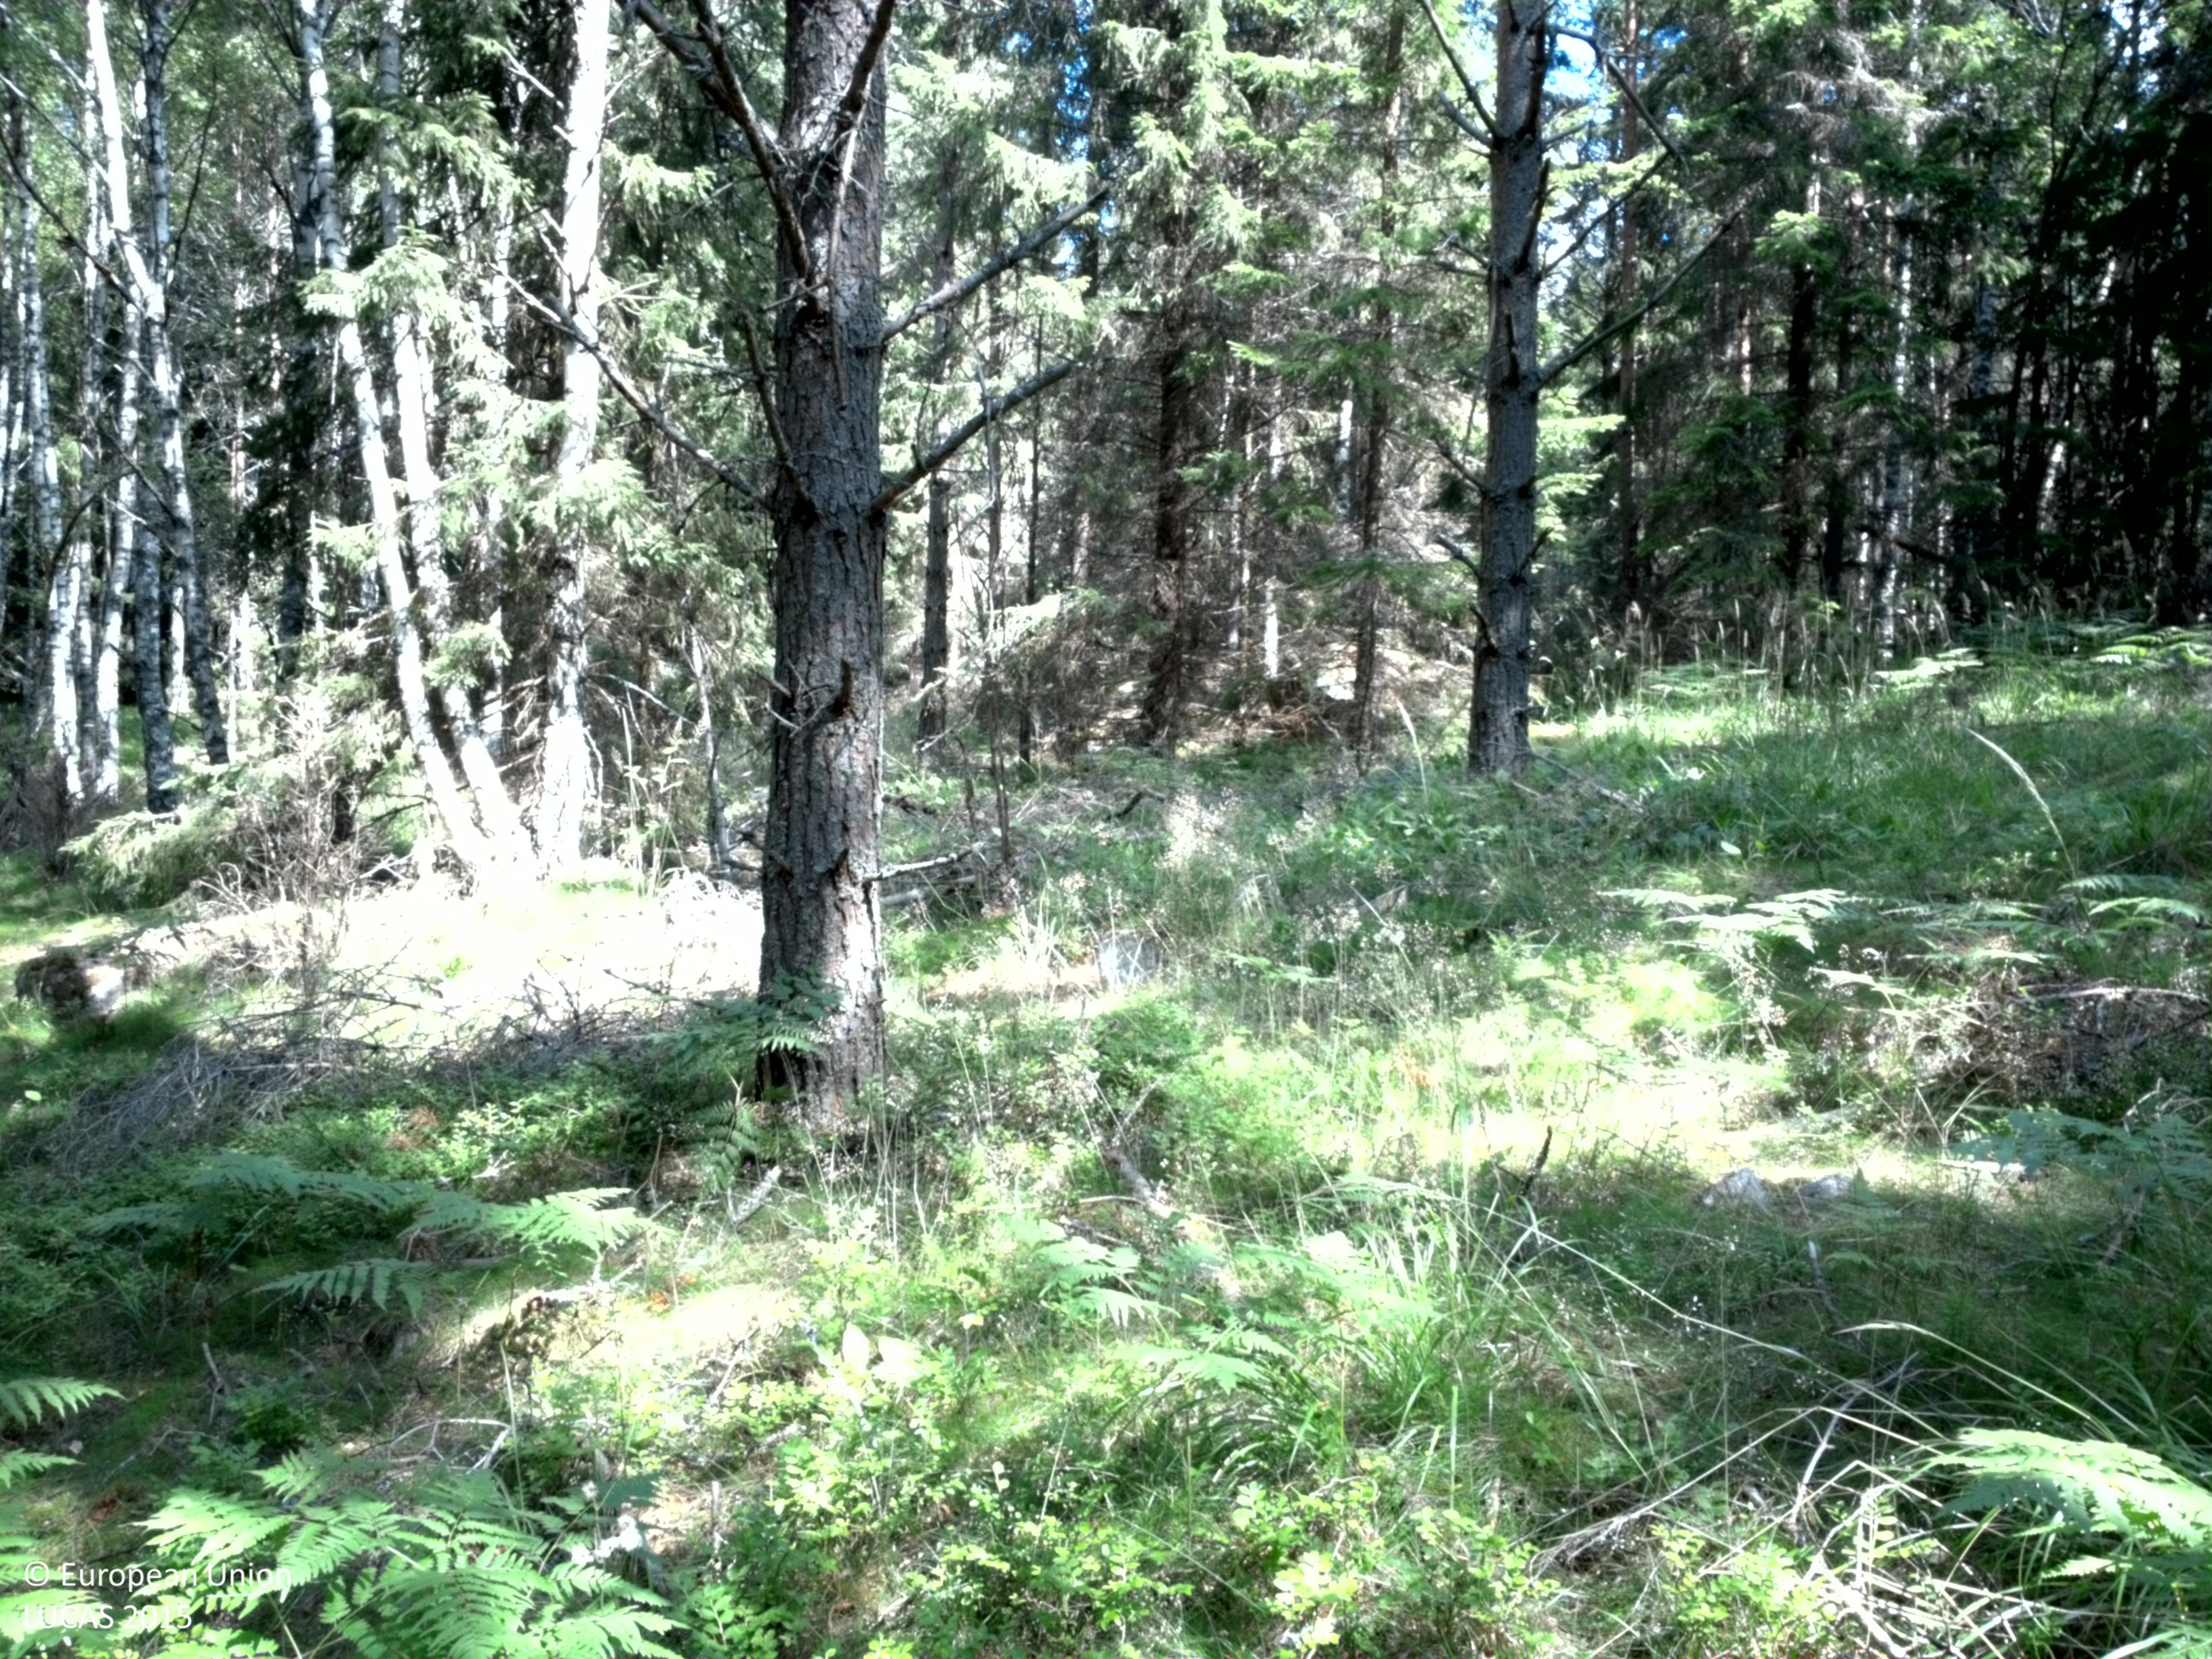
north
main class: Woodland
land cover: Pine dominated mixed woodland
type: boreal forest
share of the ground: > 75 %
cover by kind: coniferous forest trees 50 %, broadleaved forest trees 25 %, herbaceous plants 20 %, shrubs 5 %
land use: Forestry
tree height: > 5 m
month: July
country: SE
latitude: 59.6836
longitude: 18.5782
